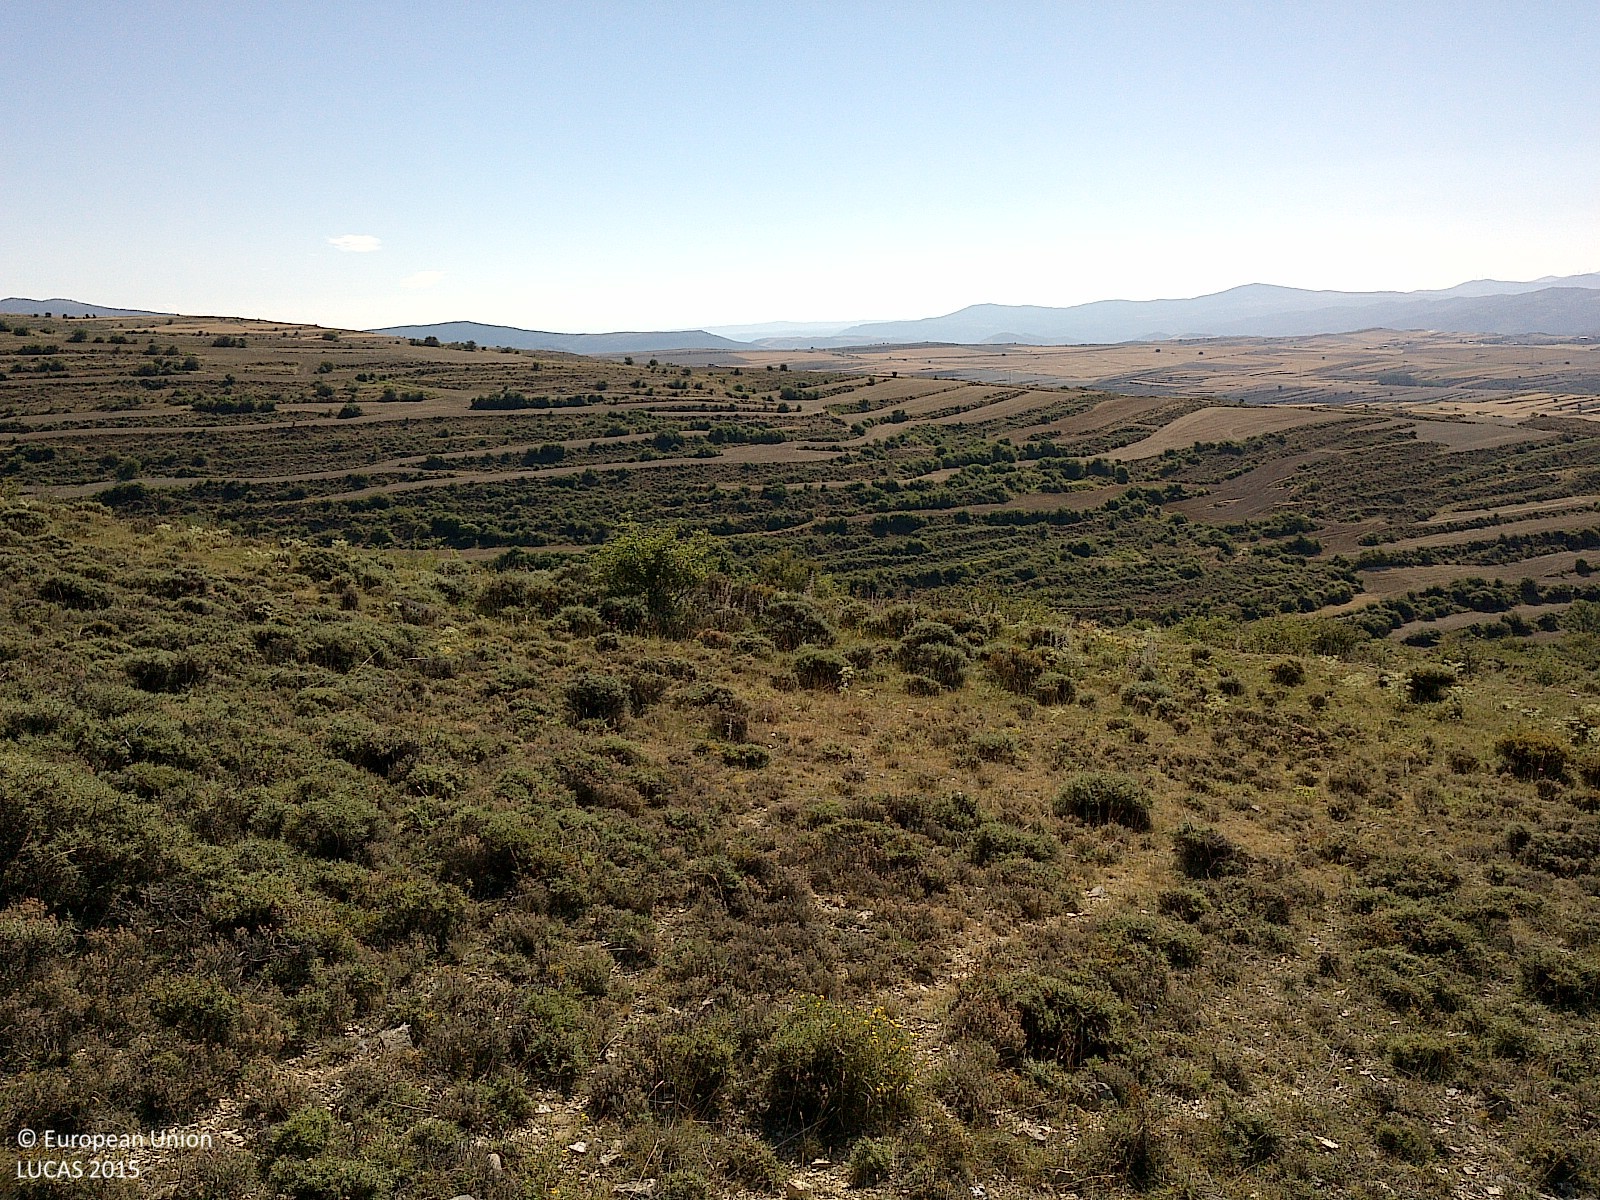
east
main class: Shrubland
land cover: Shrubland without tree cover
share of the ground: 50 - 75 %
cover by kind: shrubs 65 %, herbaceous plants 25 %, consolidated bare surface 5 %, unconsolidated bare surface 5 %
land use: Agriculture (excluding fallow land and kitchen gardens)
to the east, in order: Shrubland without tree cover; Dry stone walls; Shrubland without tree cover; Other bare soil; Shrubland without tree cover; Other bare soil; Shrubland without tree cover; Spontaneously vegetated surfaces; Shrubland without tree cover; Spontaneously vegetated surfaces; Shrubland without tree cover
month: July
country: ES
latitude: 41.9461
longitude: -2.2325
